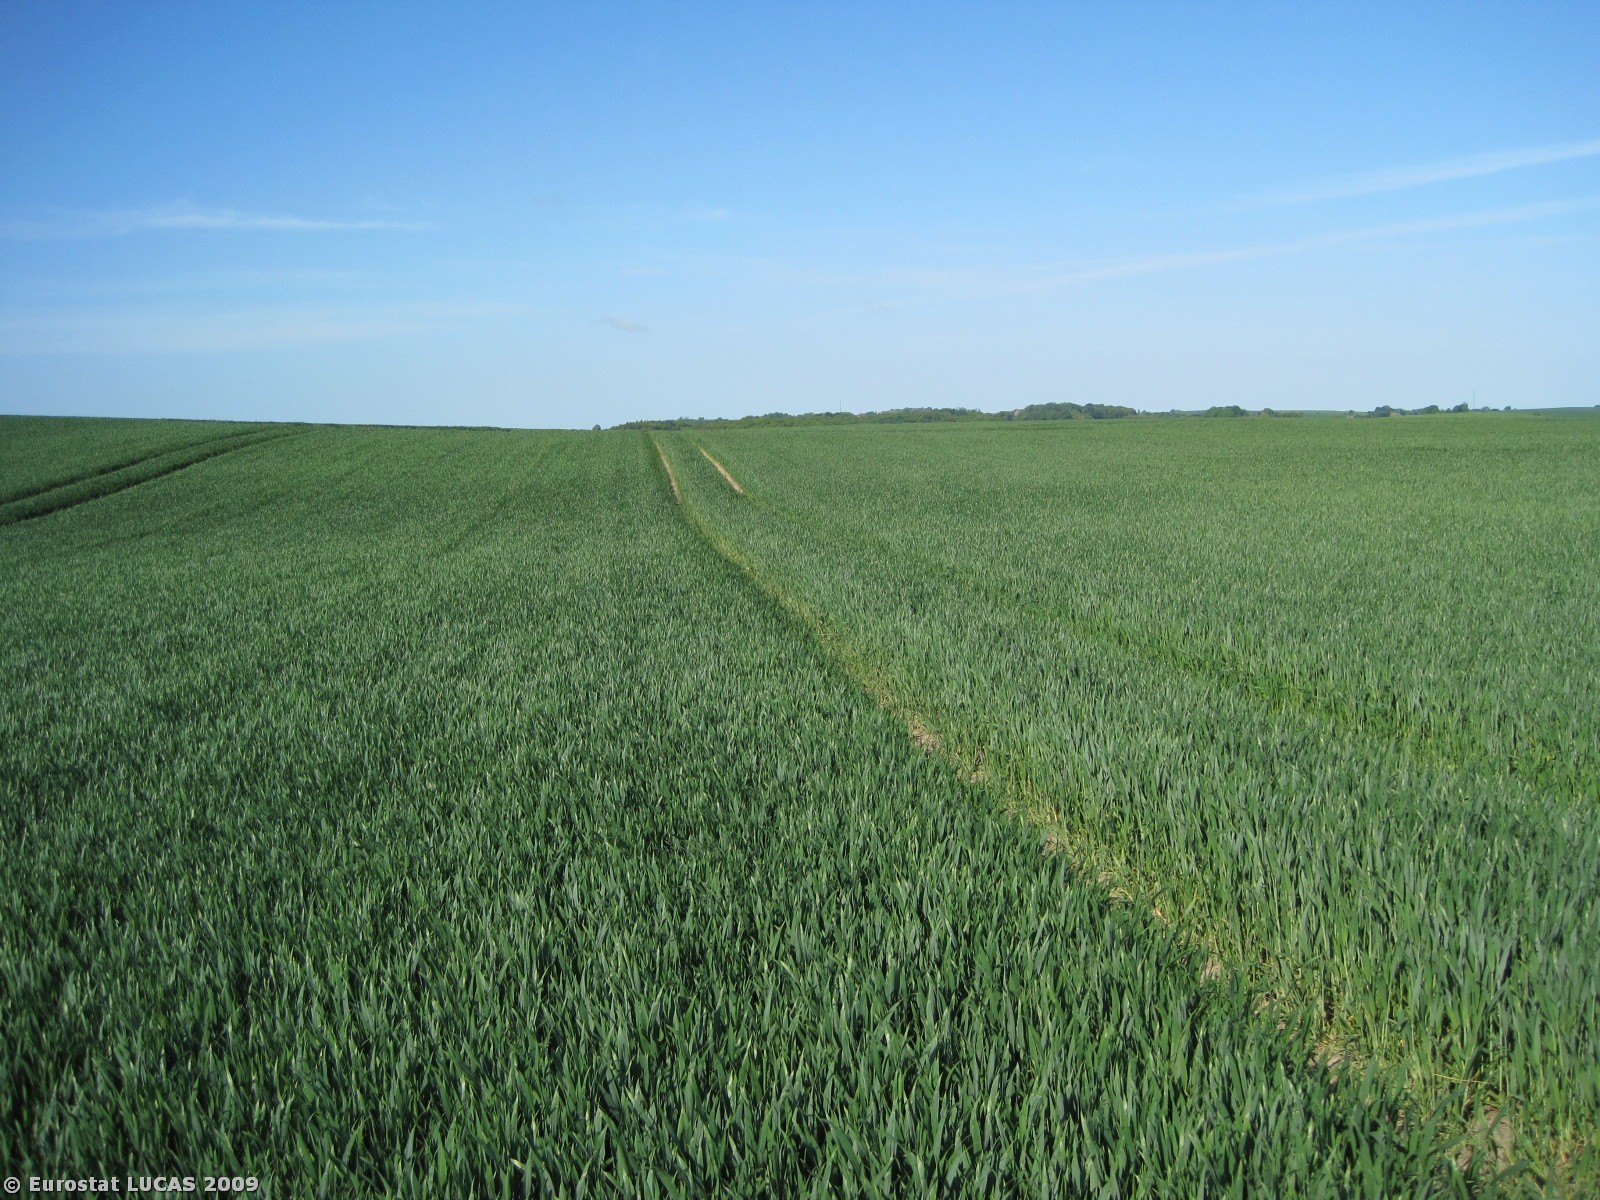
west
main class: Cropland
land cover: Common wheat
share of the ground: > 75 %
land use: Agriculture (excluding fallow land and kitchen gardens)
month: May
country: DK
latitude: 56.5651
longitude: 10.1788
